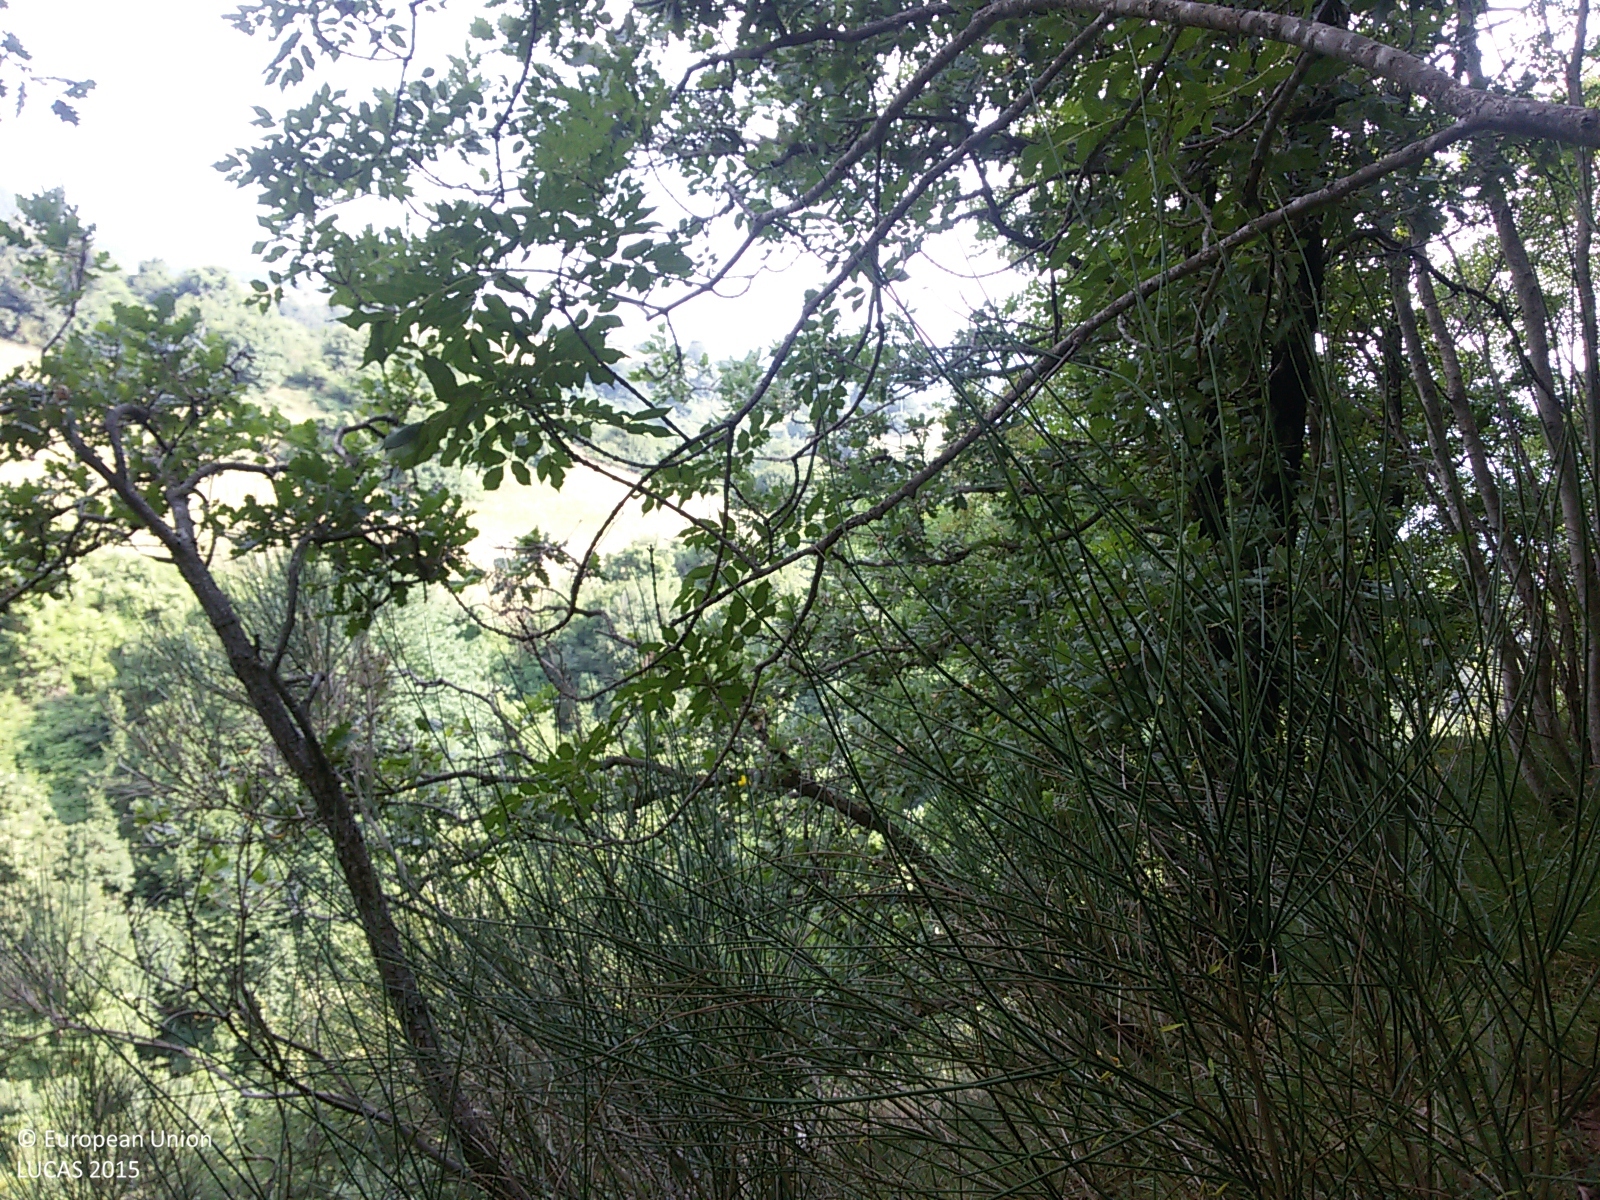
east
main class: Woodland
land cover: Broadleaved woodland
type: thermophilous deciduous forest
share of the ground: 50 - 75 %
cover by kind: broadleaved forest trees 55 %, shrubs 20 %, consolidated bare surface 15 %, herbaceous plants 10 %
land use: Semi-natural and natural areas not in use
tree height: < 5 m
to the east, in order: Broadleaved woodland; Grassland with sparse tree/shrub cover; Managed hedges; Grassland with sparse tree/shrub cover
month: July
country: IT
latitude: 42.8420
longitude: 11.4758
